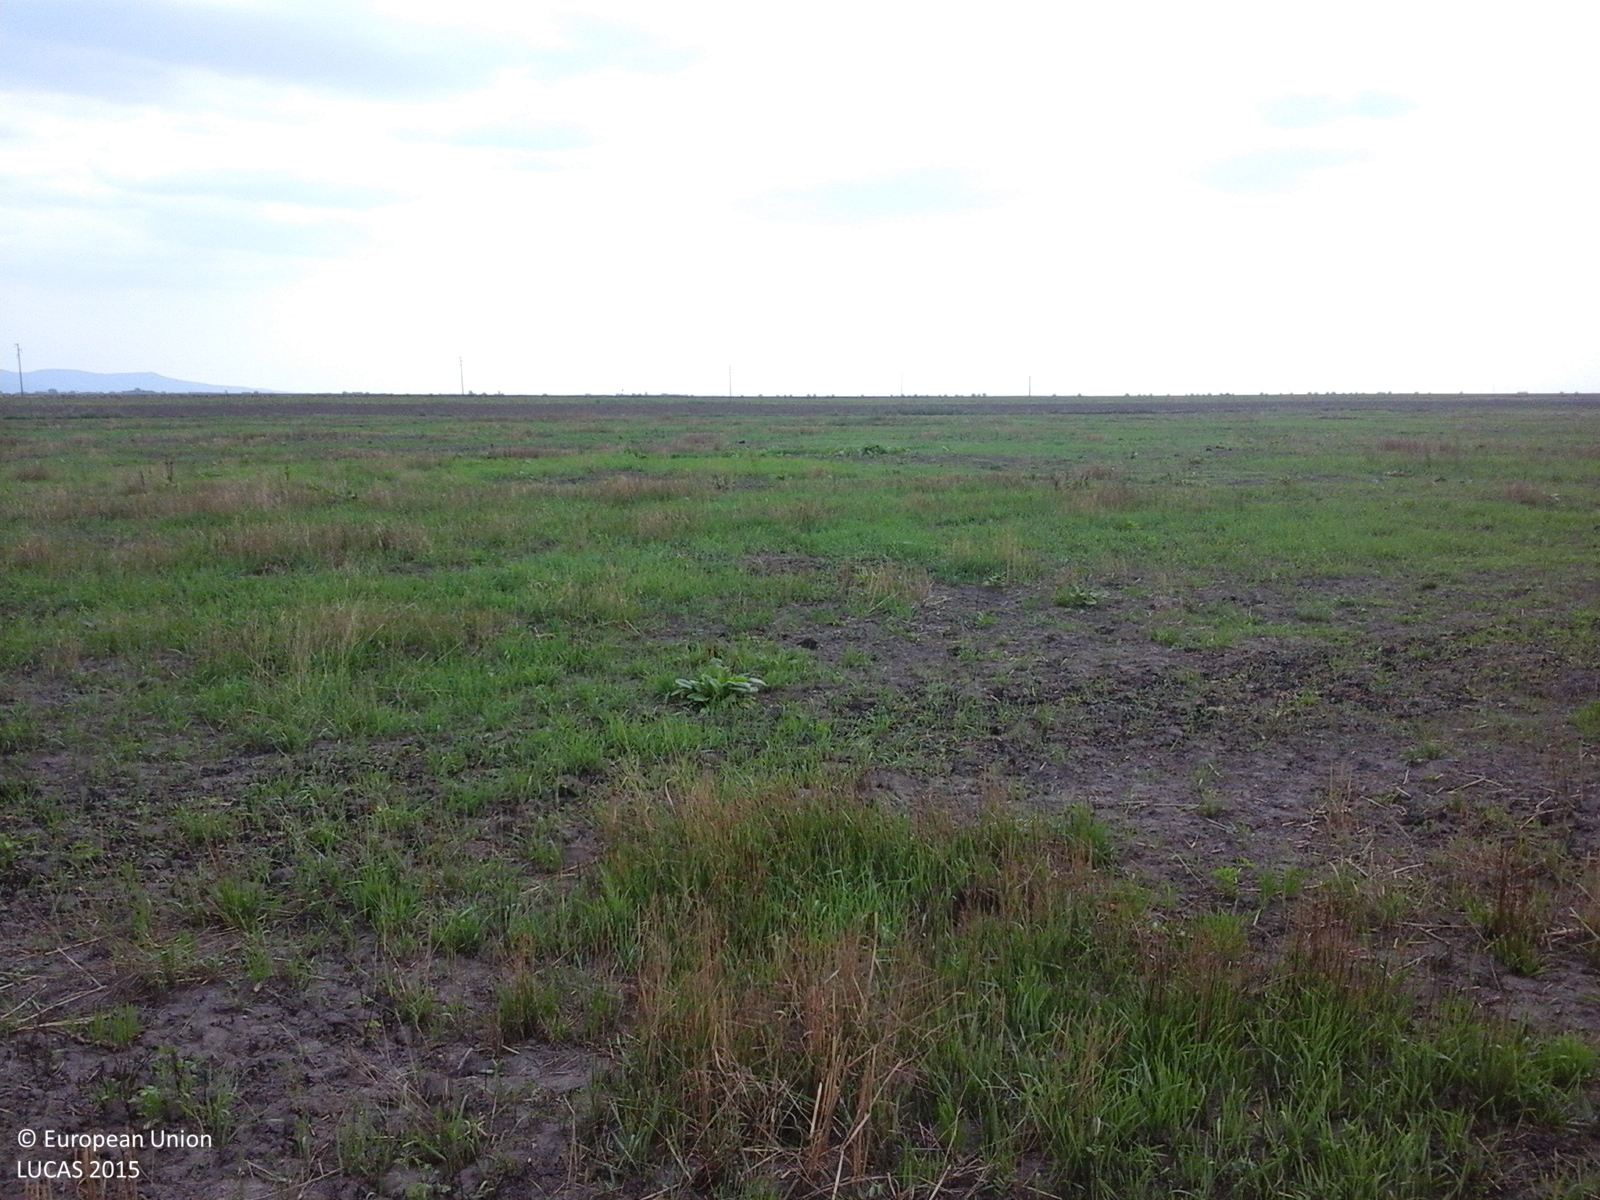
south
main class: Cropland
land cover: Durum wheat
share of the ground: 10 - 25 %
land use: Agriculture (excluding fallow land and kitchen gardens)
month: August
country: RO
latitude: 46.3758
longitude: 21.5696
